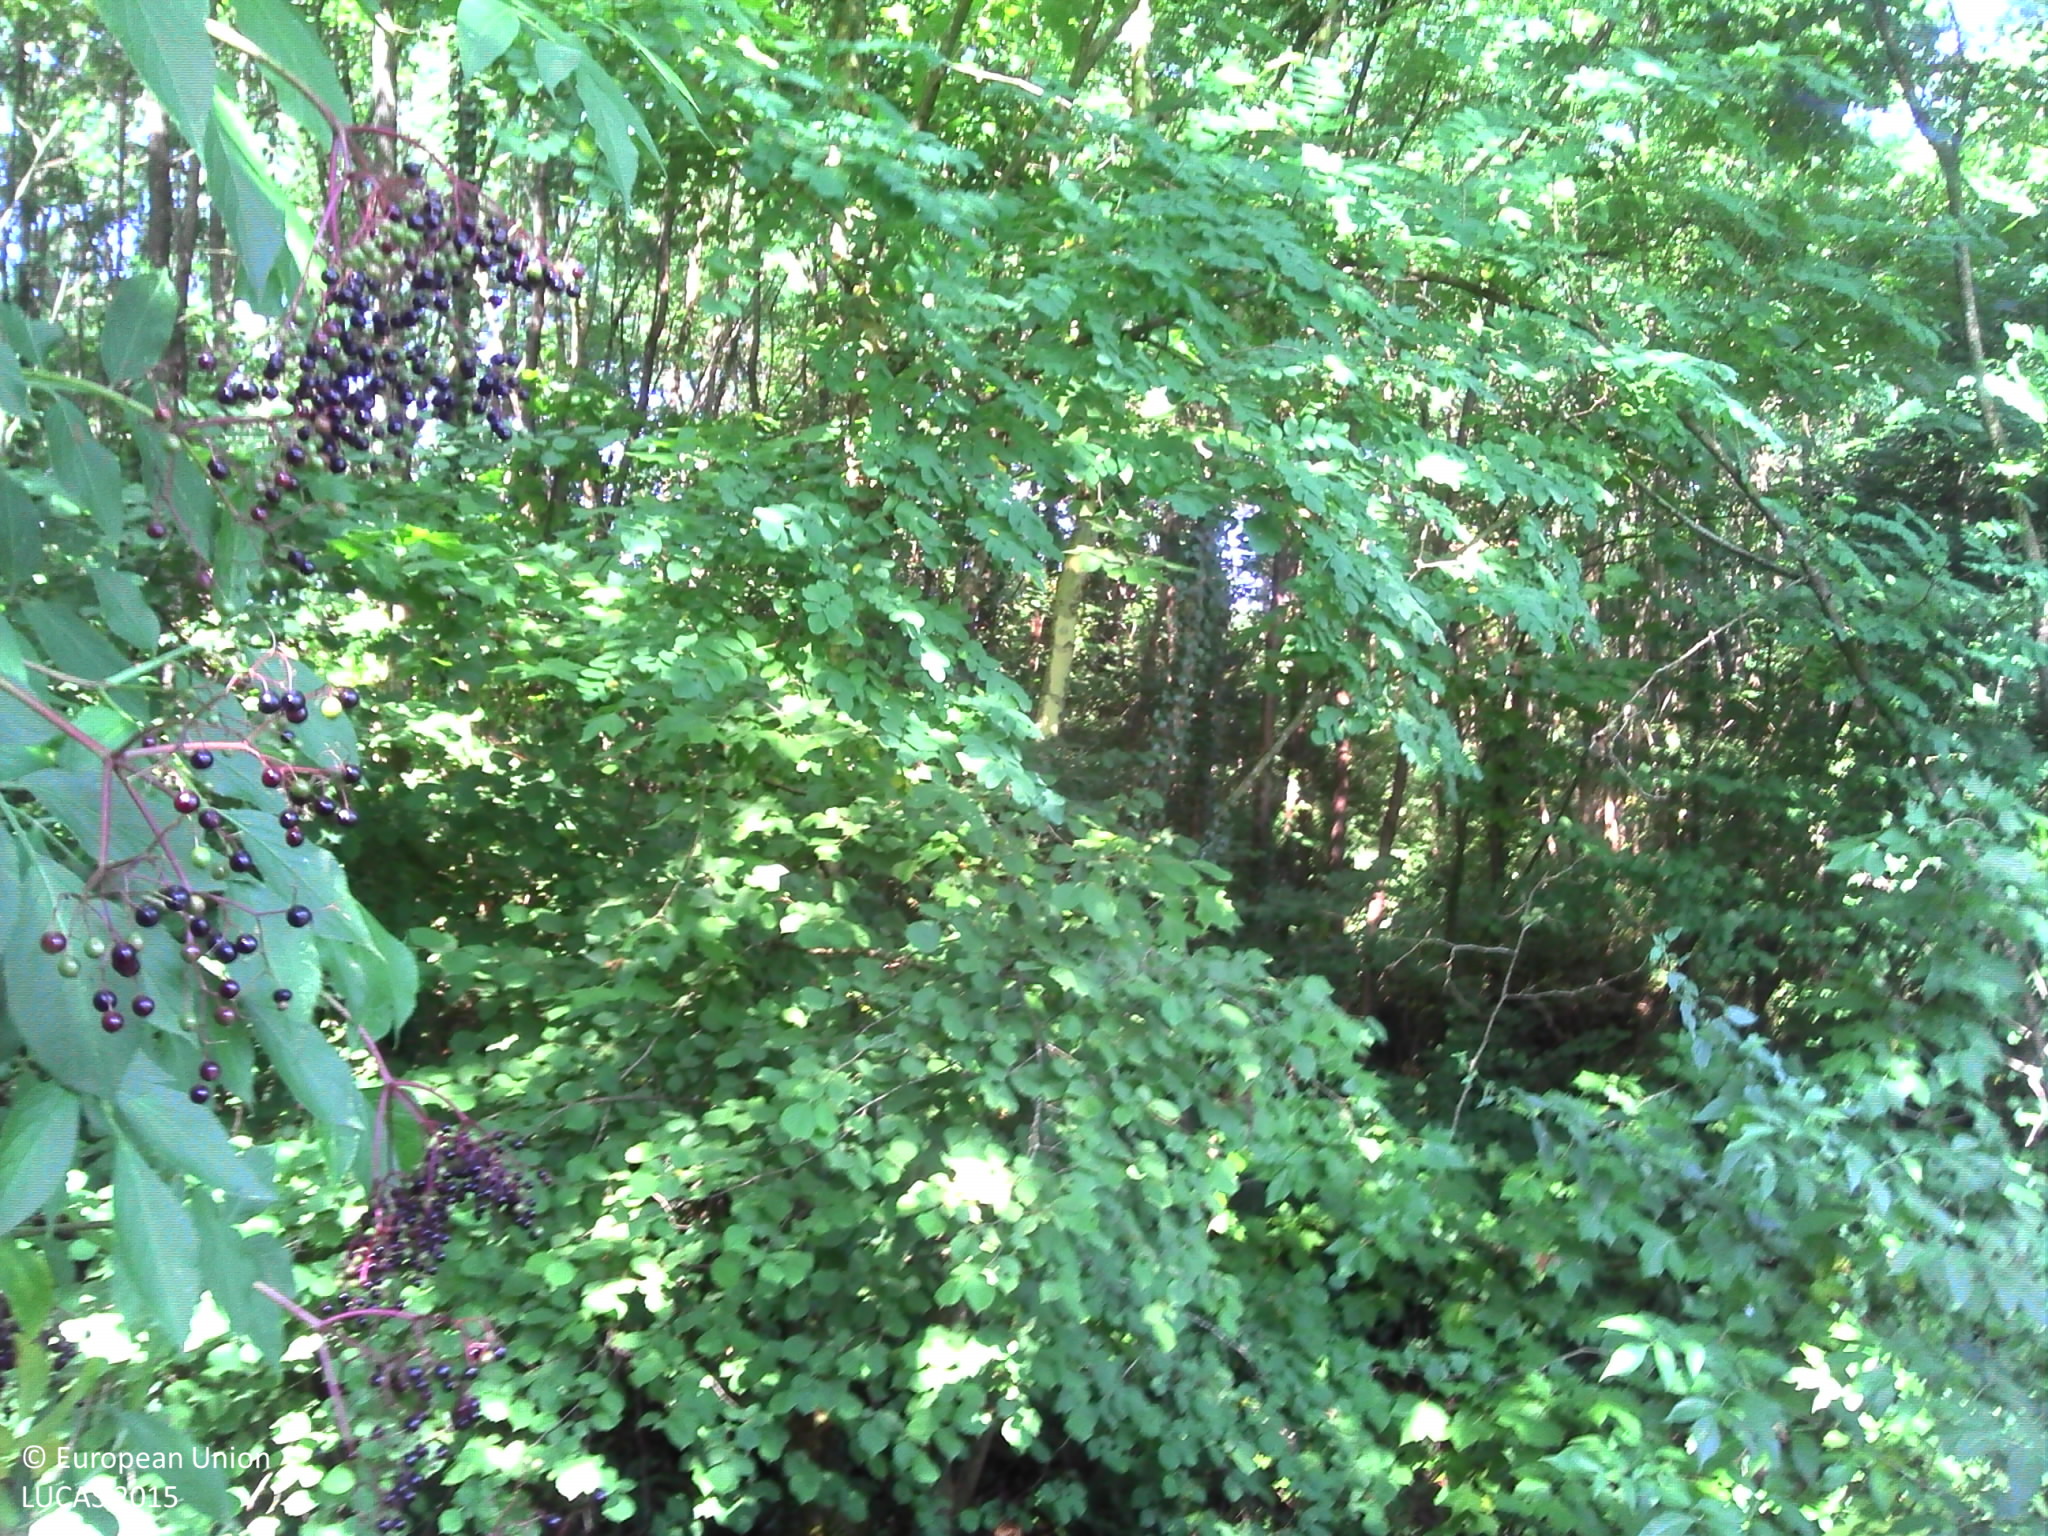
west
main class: Woodland
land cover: Broadleaved woodland
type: thermophilous deciduous forest
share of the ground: > 75 %
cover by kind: broadleaved forest trees 65 %, shrubs 20 %, herbaceous plants 10 %, lichens and mosses 5 %
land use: Forestry
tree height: > 5 m
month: August
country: FR
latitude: 43.4771
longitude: -1.1289
